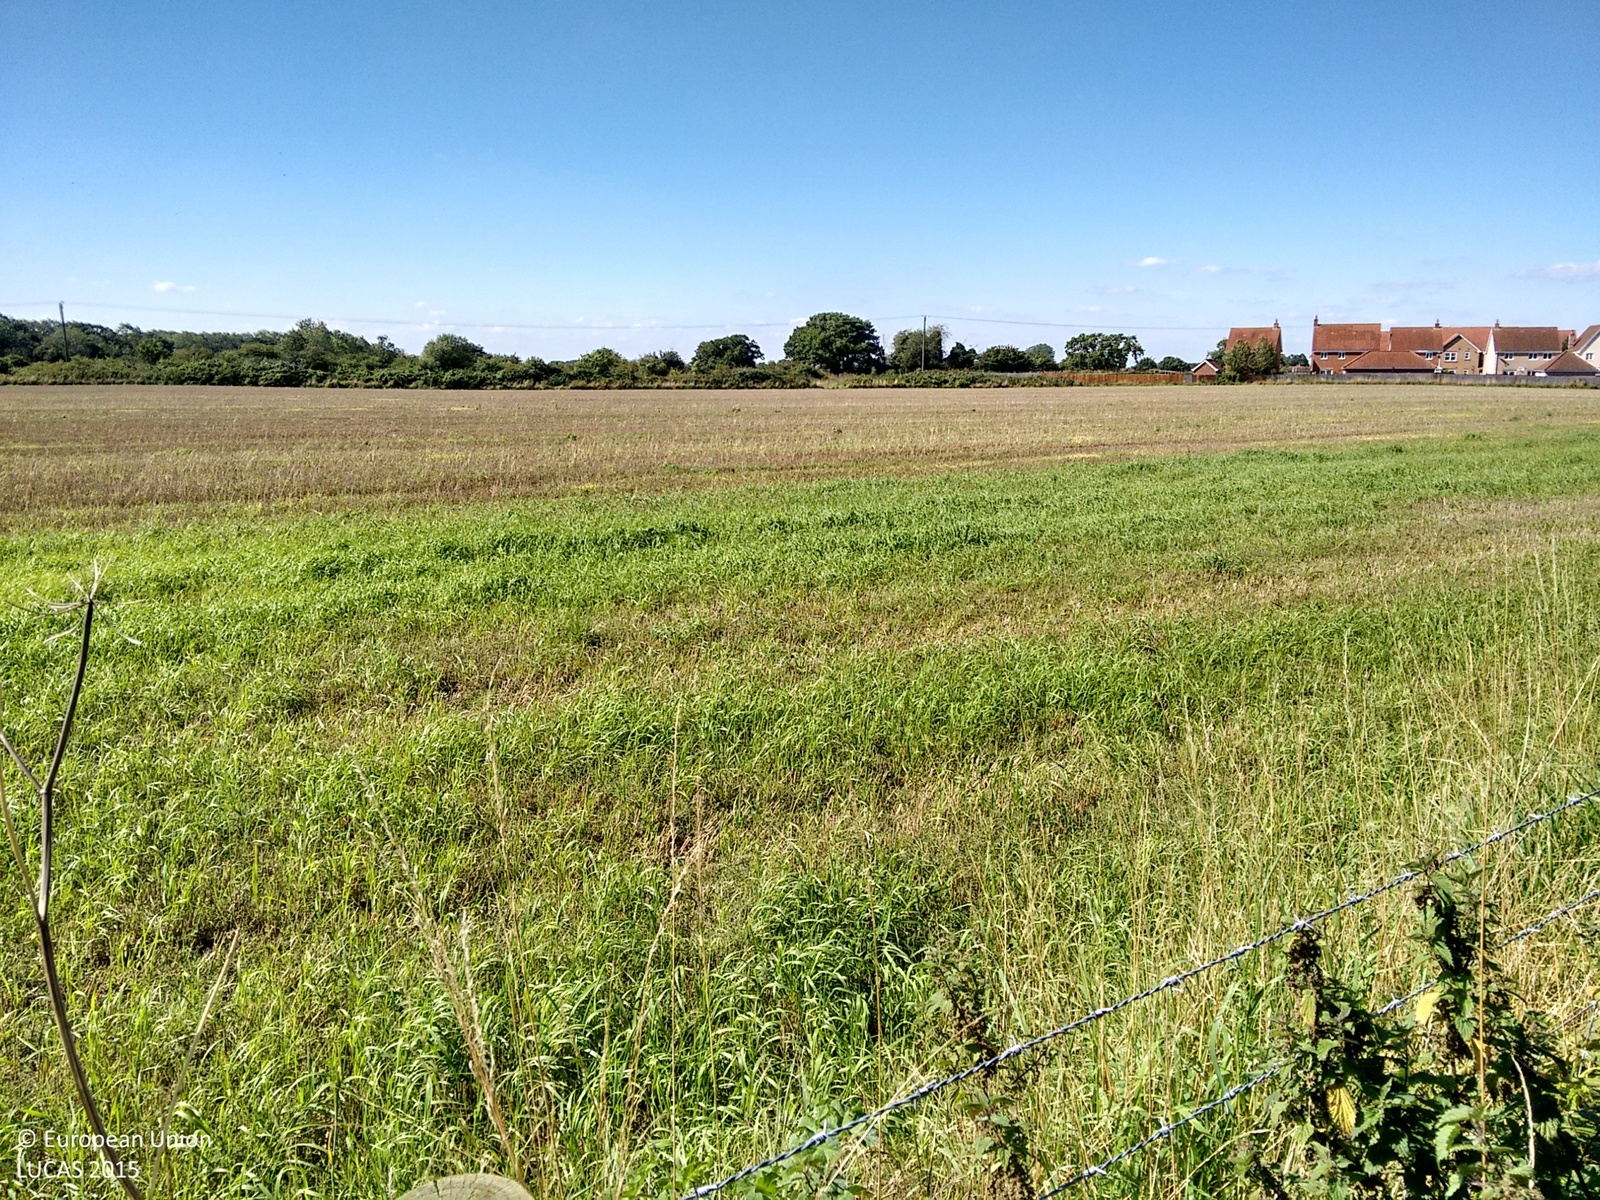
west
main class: Cropland
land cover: Common wheat
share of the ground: > 75 %
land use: Agriculture (excluding fallow land and kitchen gardens)
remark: Harvested field
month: September
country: GB
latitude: 52.5659
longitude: 0.8436
